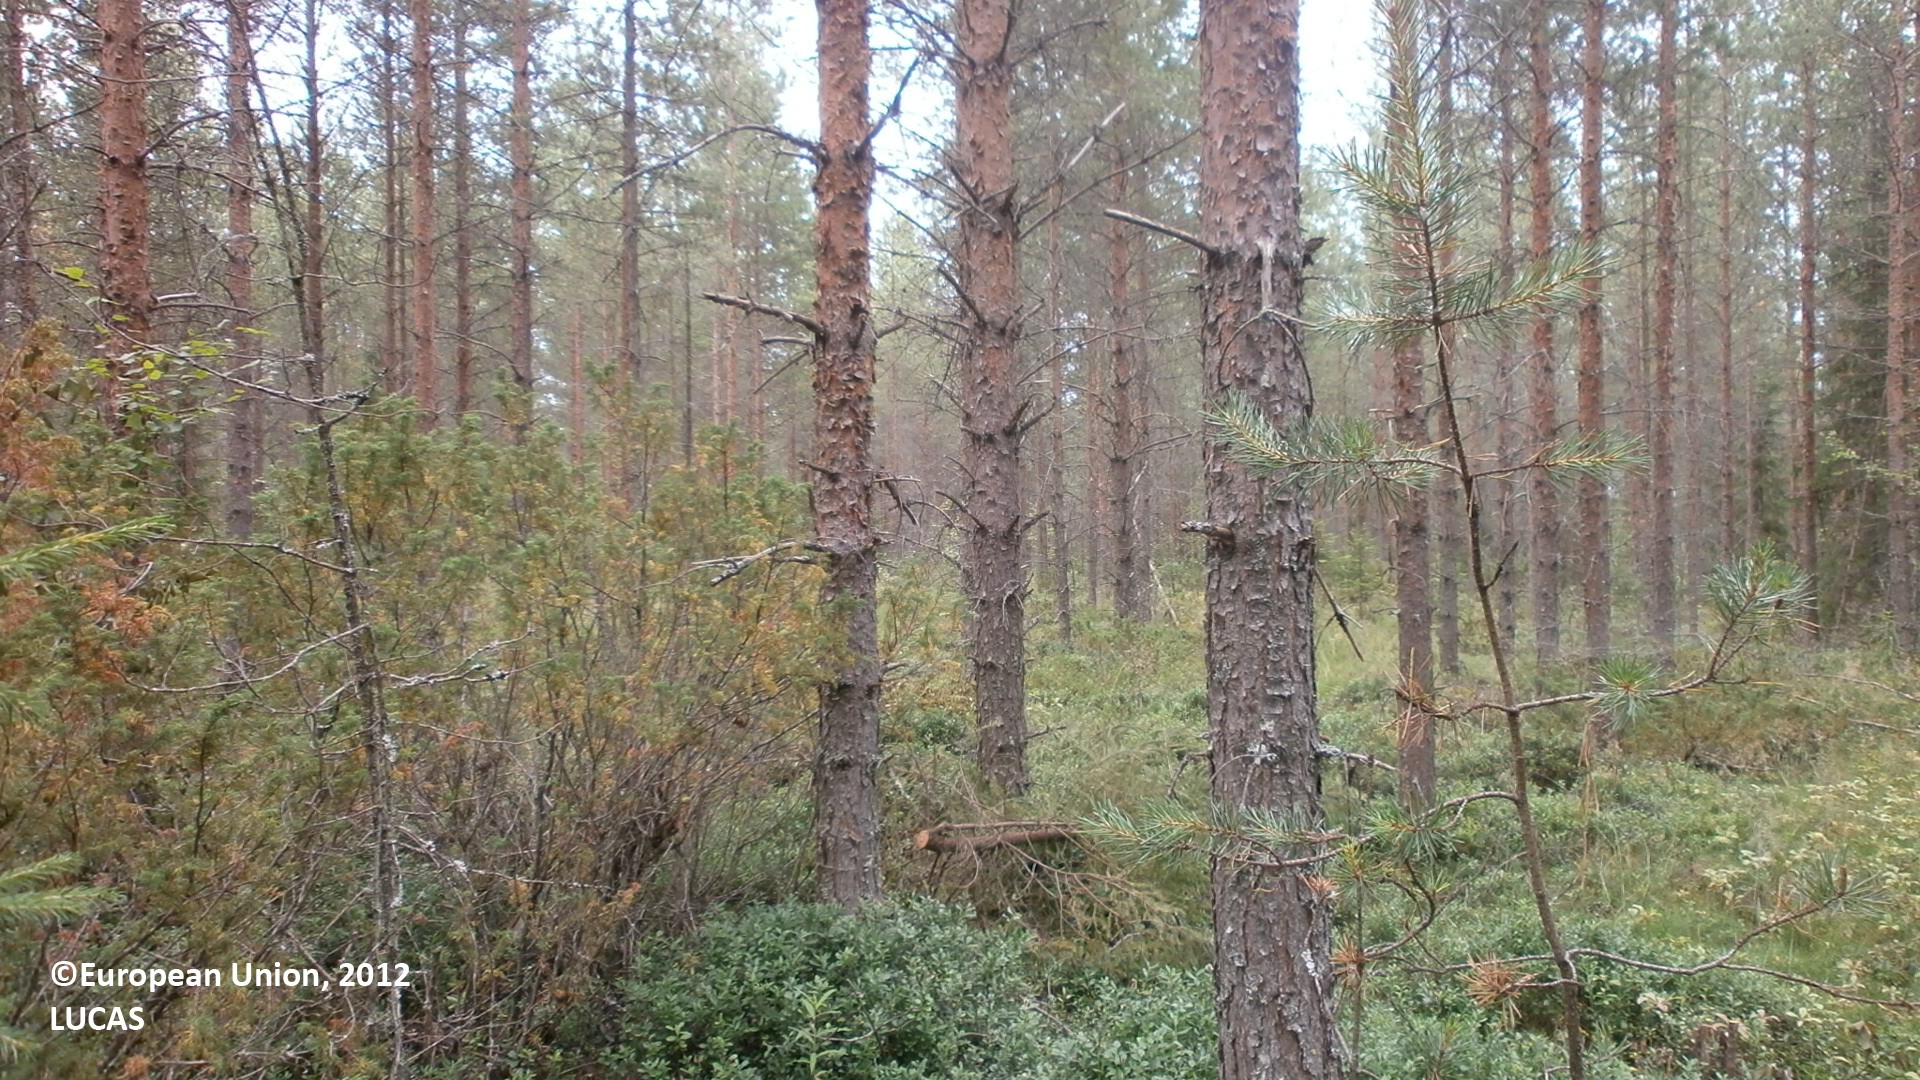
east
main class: Woodland
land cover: Pine dominated coniferous woodland
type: boreal forest
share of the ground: 50 - 75 %
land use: Forestry
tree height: > 5 m
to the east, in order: Pine dominated coniferous woodland; Tracks; Pine dominated coniferous woodland; Tracks; Pine dominated coniferous woodland; Tracks; Pine dominated coniferous woodland; Tracks; Pine dominated coniferous woodland; Ditches and canals; Pine dominated coniferous woodland
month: July
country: FI
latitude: 64.0203
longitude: 23.9156
